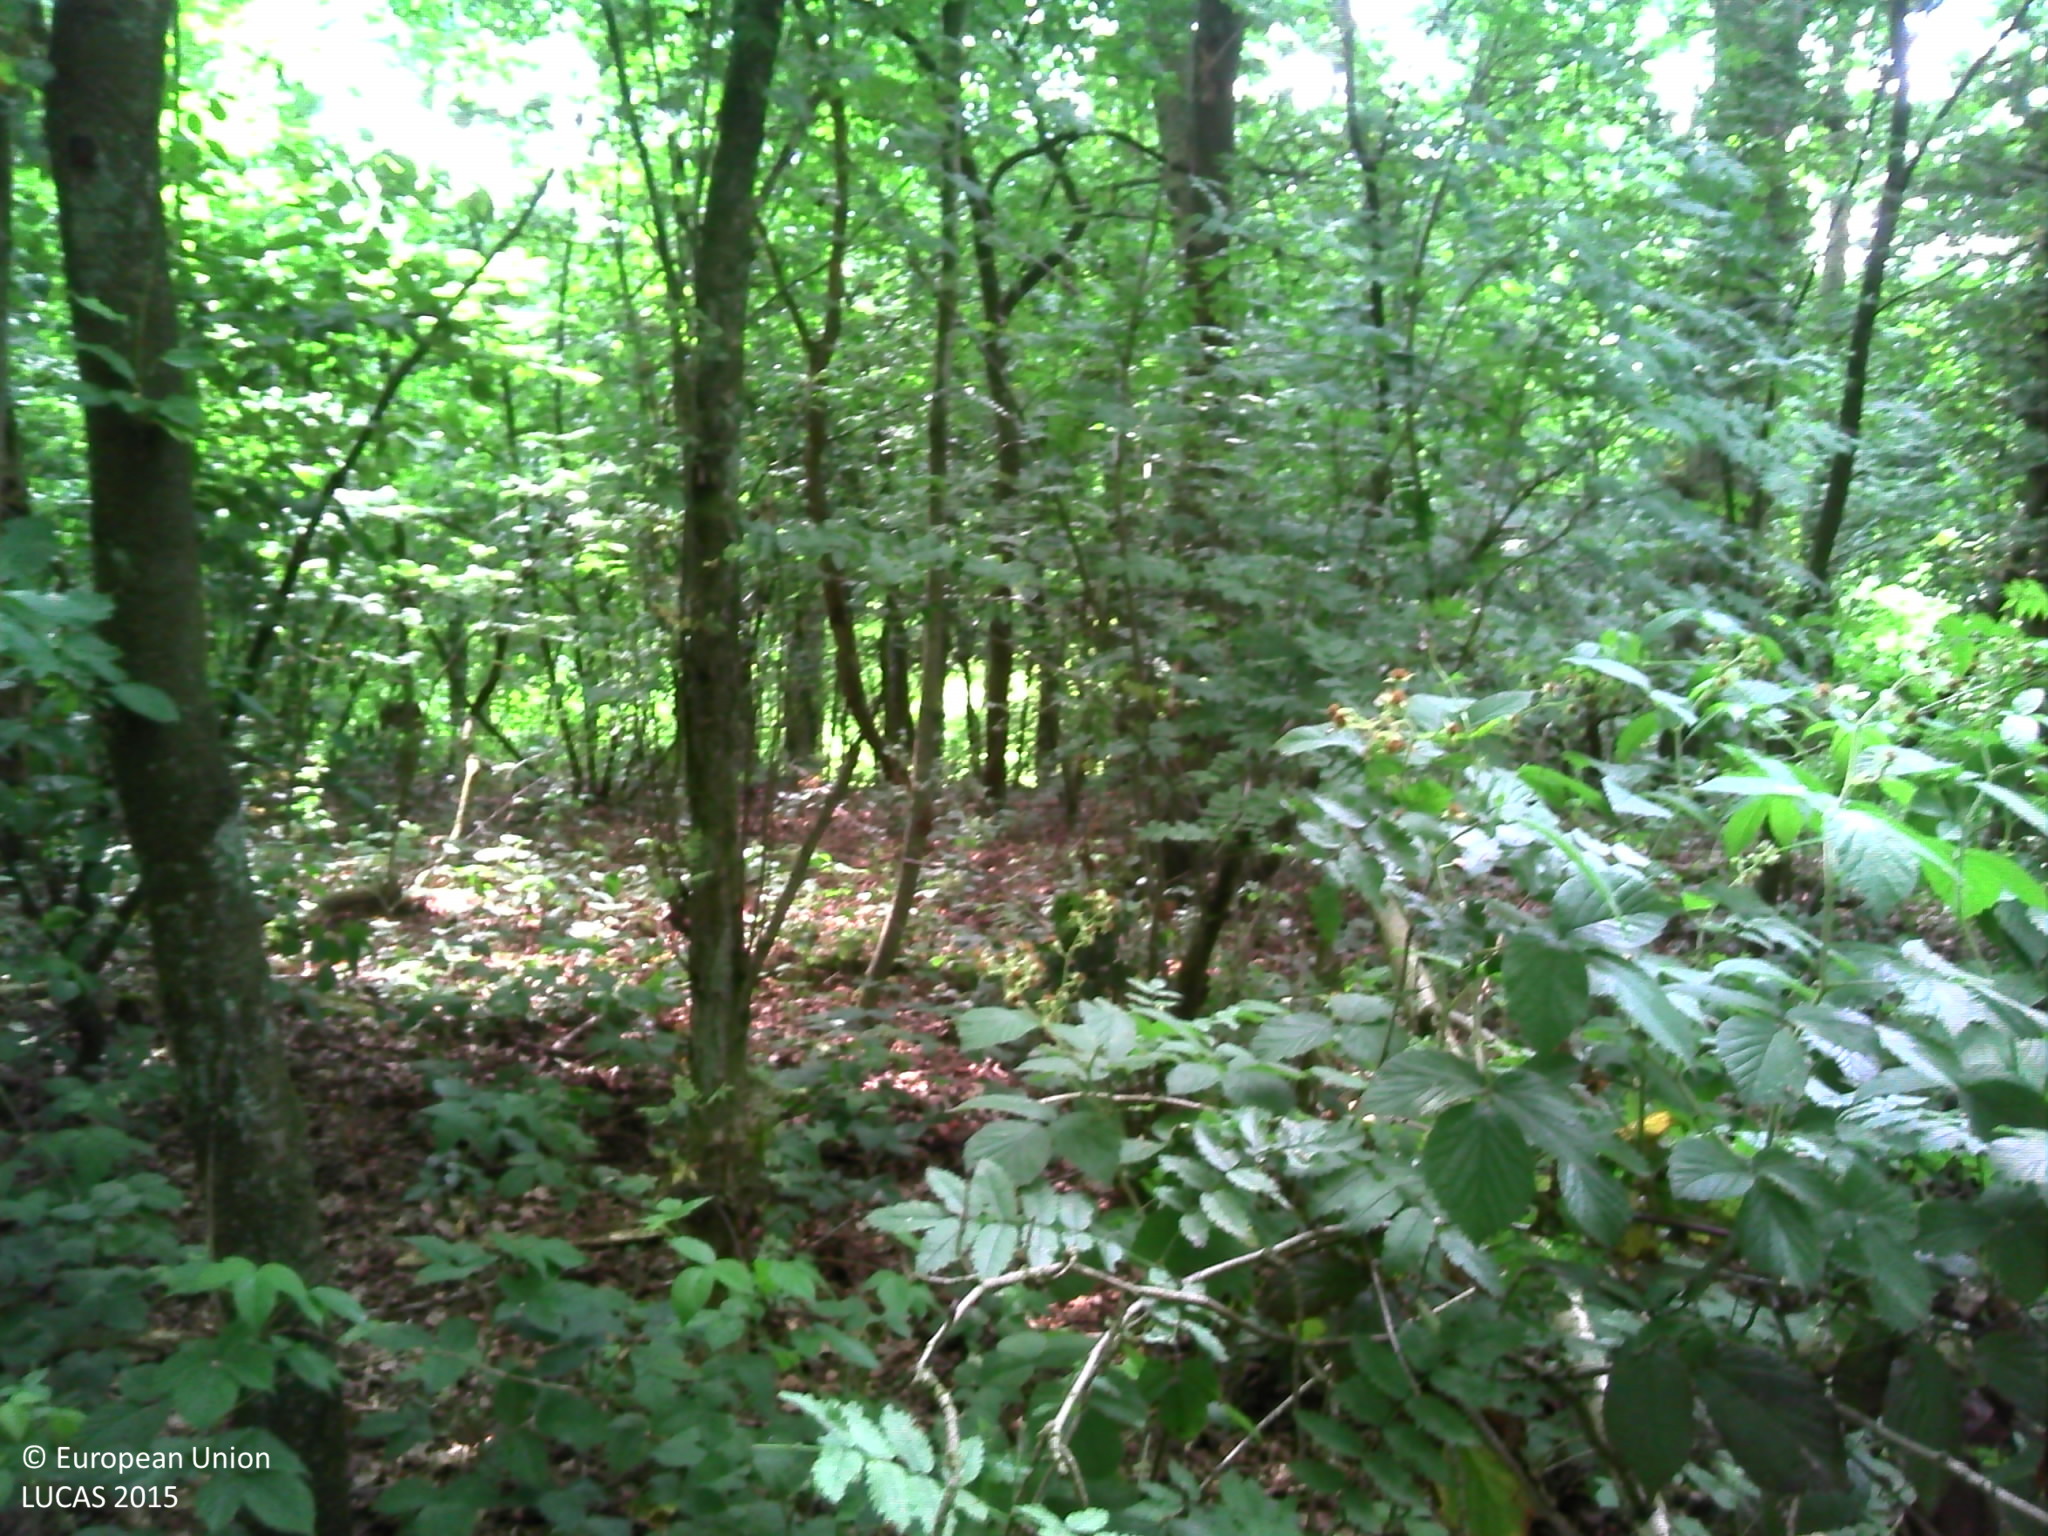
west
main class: Woodland
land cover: Broadleaved woodland
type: acidophilous oak and oak-birch forest
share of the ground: > 75 %
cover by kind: broadleaved forest trees 100 %
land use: Forestry
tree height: > 5 m
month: May
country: BE
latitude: 50.5564
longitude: 4.5050
